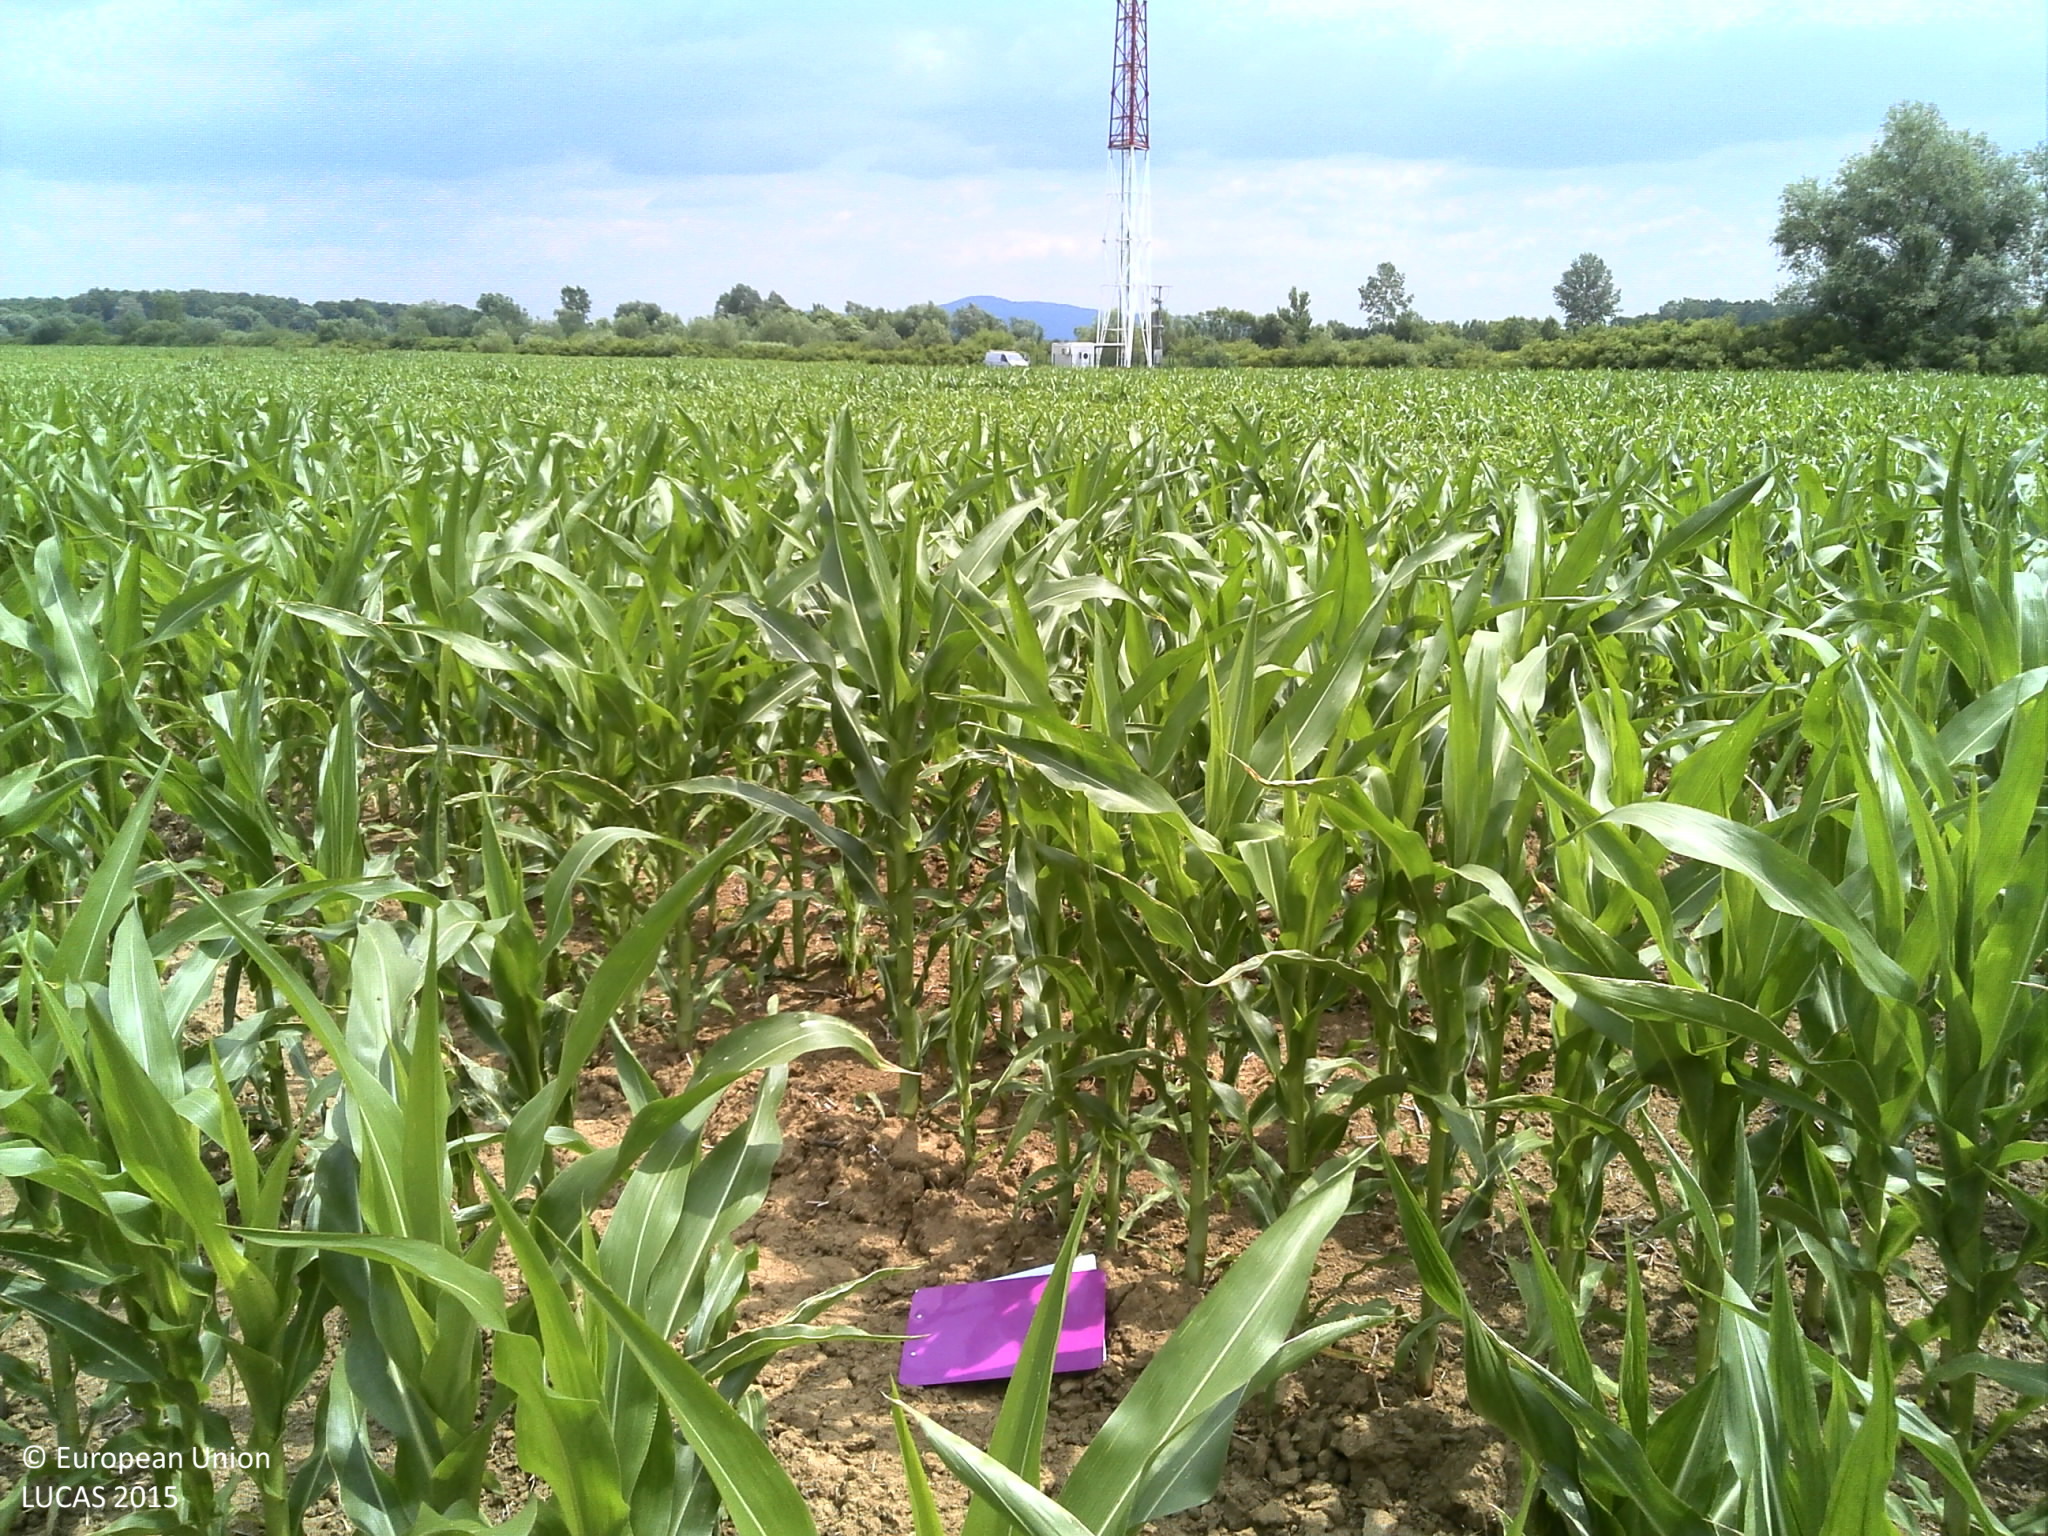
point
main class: Cropland
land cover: Maize
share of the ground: 50 - 75 %
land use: Agriculture (excluding fallow land and kitchen gardens)
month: June
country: HR
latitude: 45.1691
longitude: 17.4432
